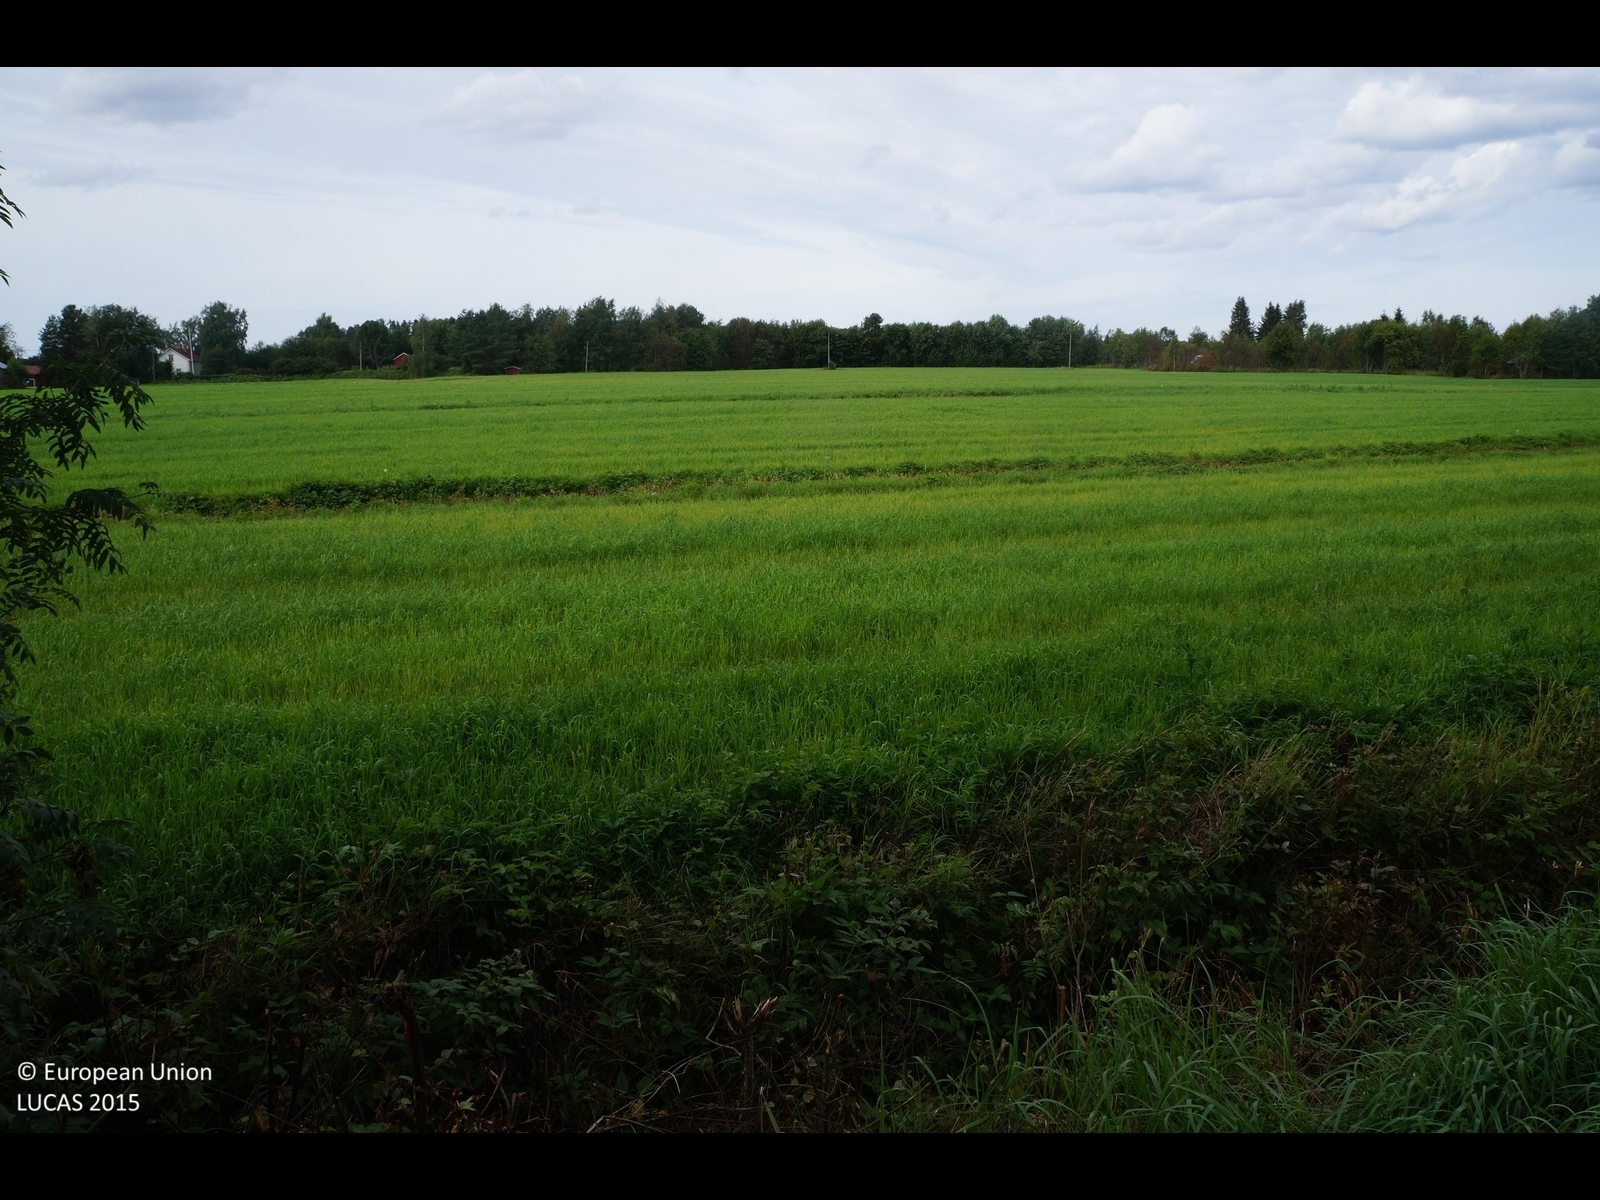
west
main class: Cropland
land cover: Temporary grasslands
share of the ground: > 75 %
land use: Agriculture (excluding fallow land and kitchen gardens)
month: August
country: FI
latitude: 64.8284
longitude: 24.7572
